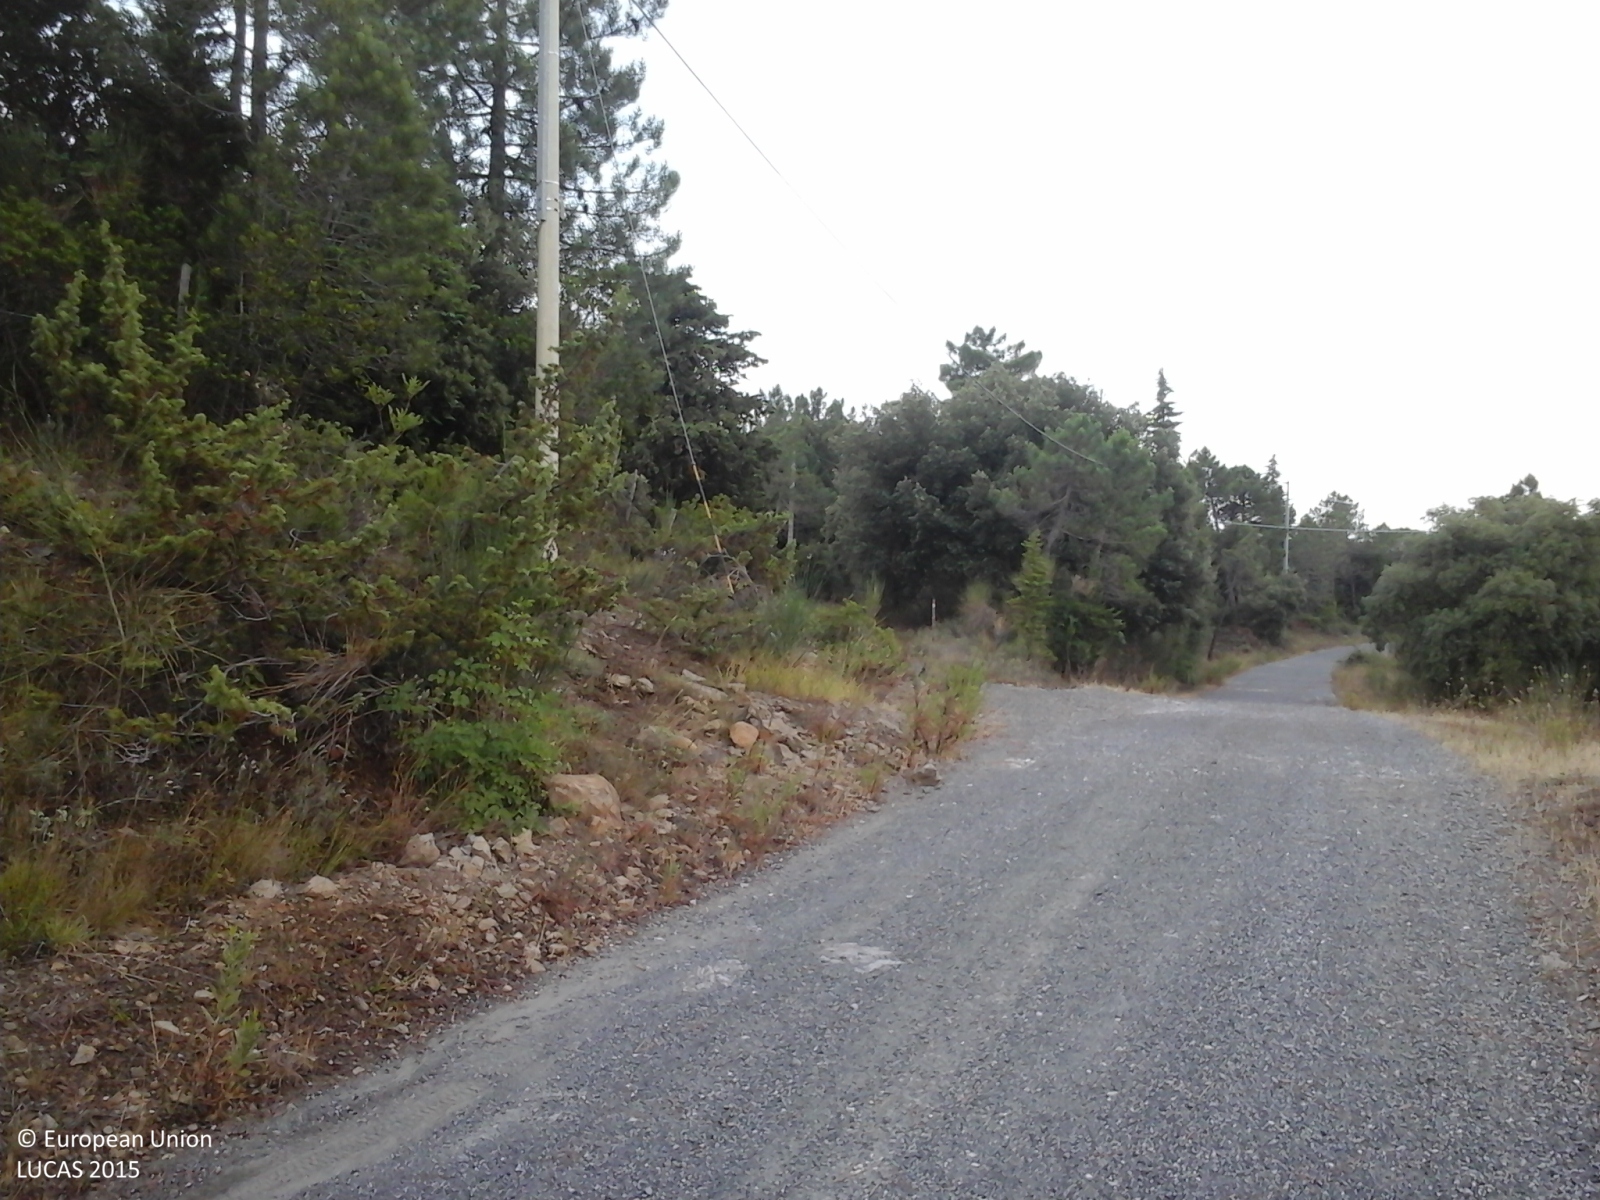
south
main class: Woodland
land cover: Other mixed woodland
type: thermophilous deciduous forest
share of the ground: > 75 %
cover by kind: broadleaved forest trees 60 %, coniferous forest trees 40 %
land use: Forestry
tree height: > 5 m
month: July
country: IT
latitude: 43.4804
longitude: 10.9246
